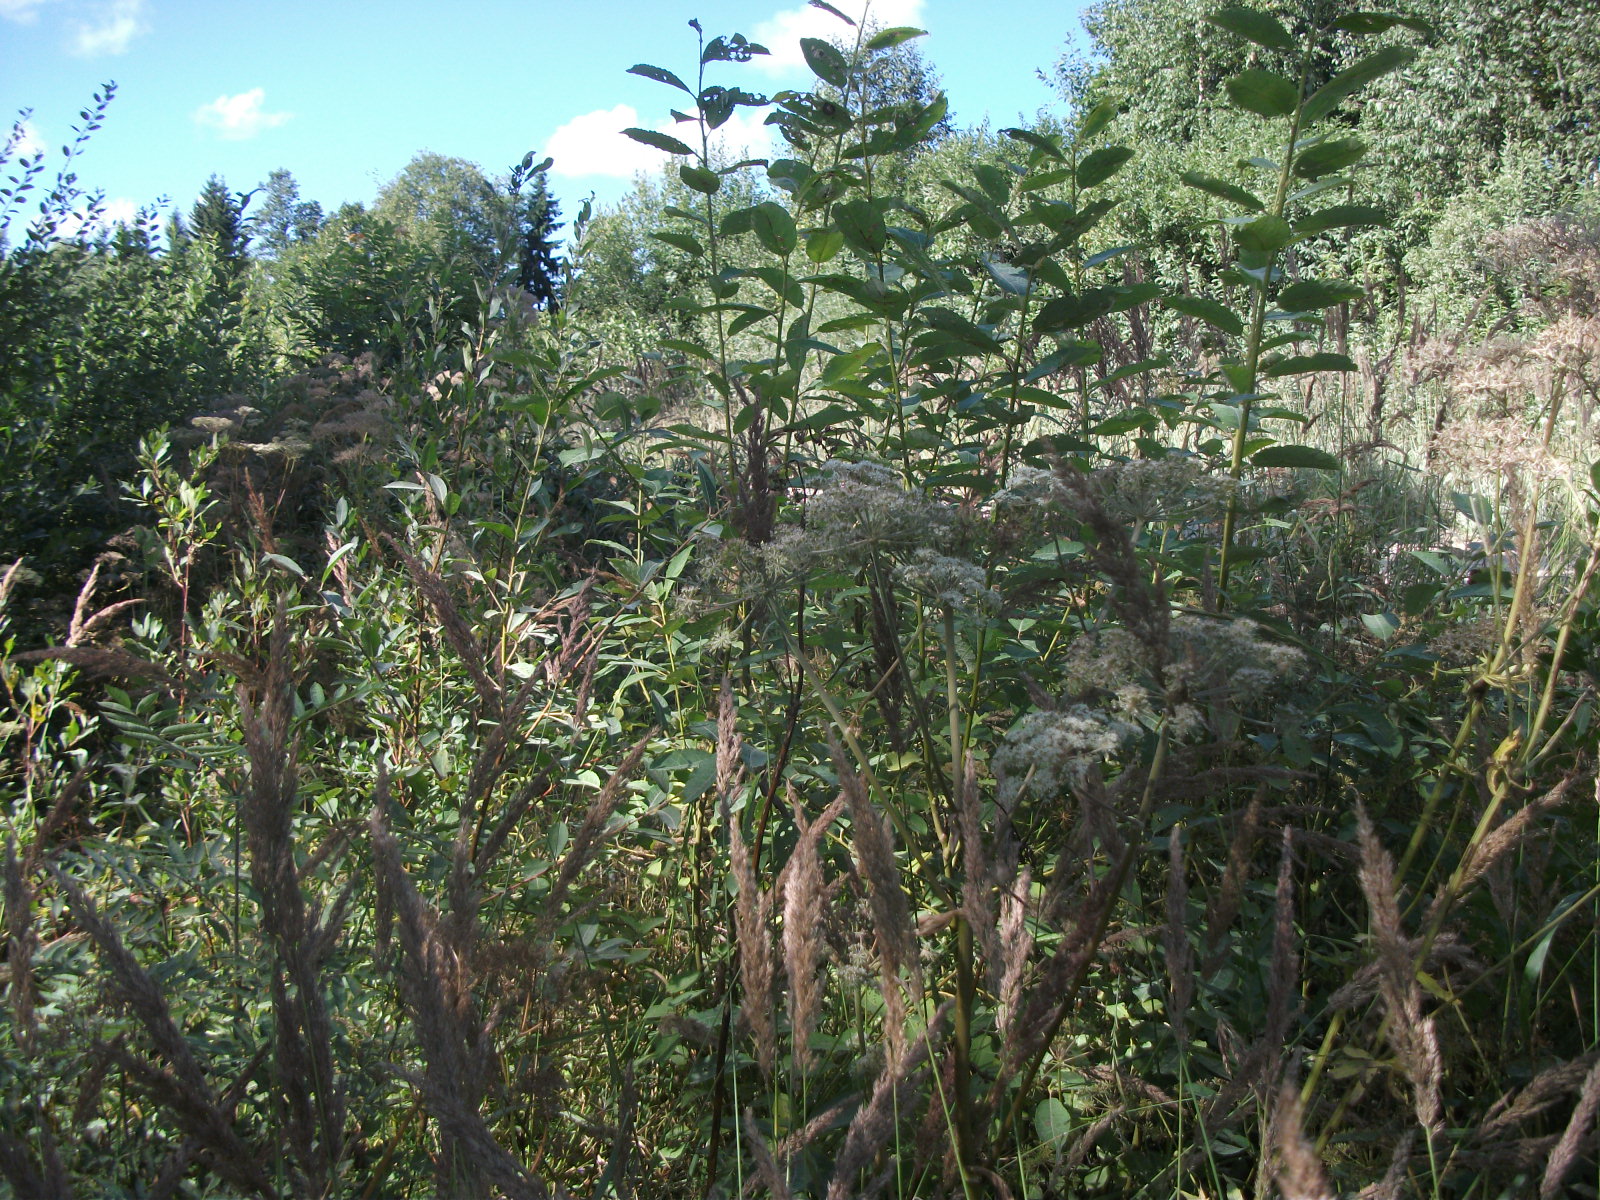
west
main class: Woodland
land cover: Broadleaved woodland
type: non-riverine alder, birch or aspen forest
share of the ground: 50 - 75 %
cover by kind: broadleaved forest trees 50 %, shrubs 30 %, herbaceous plants 20 %
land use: Semi-natural and natural areas not in use
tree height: > 5 m
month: August
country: LV
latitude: 56.6122
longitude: 26.2545
